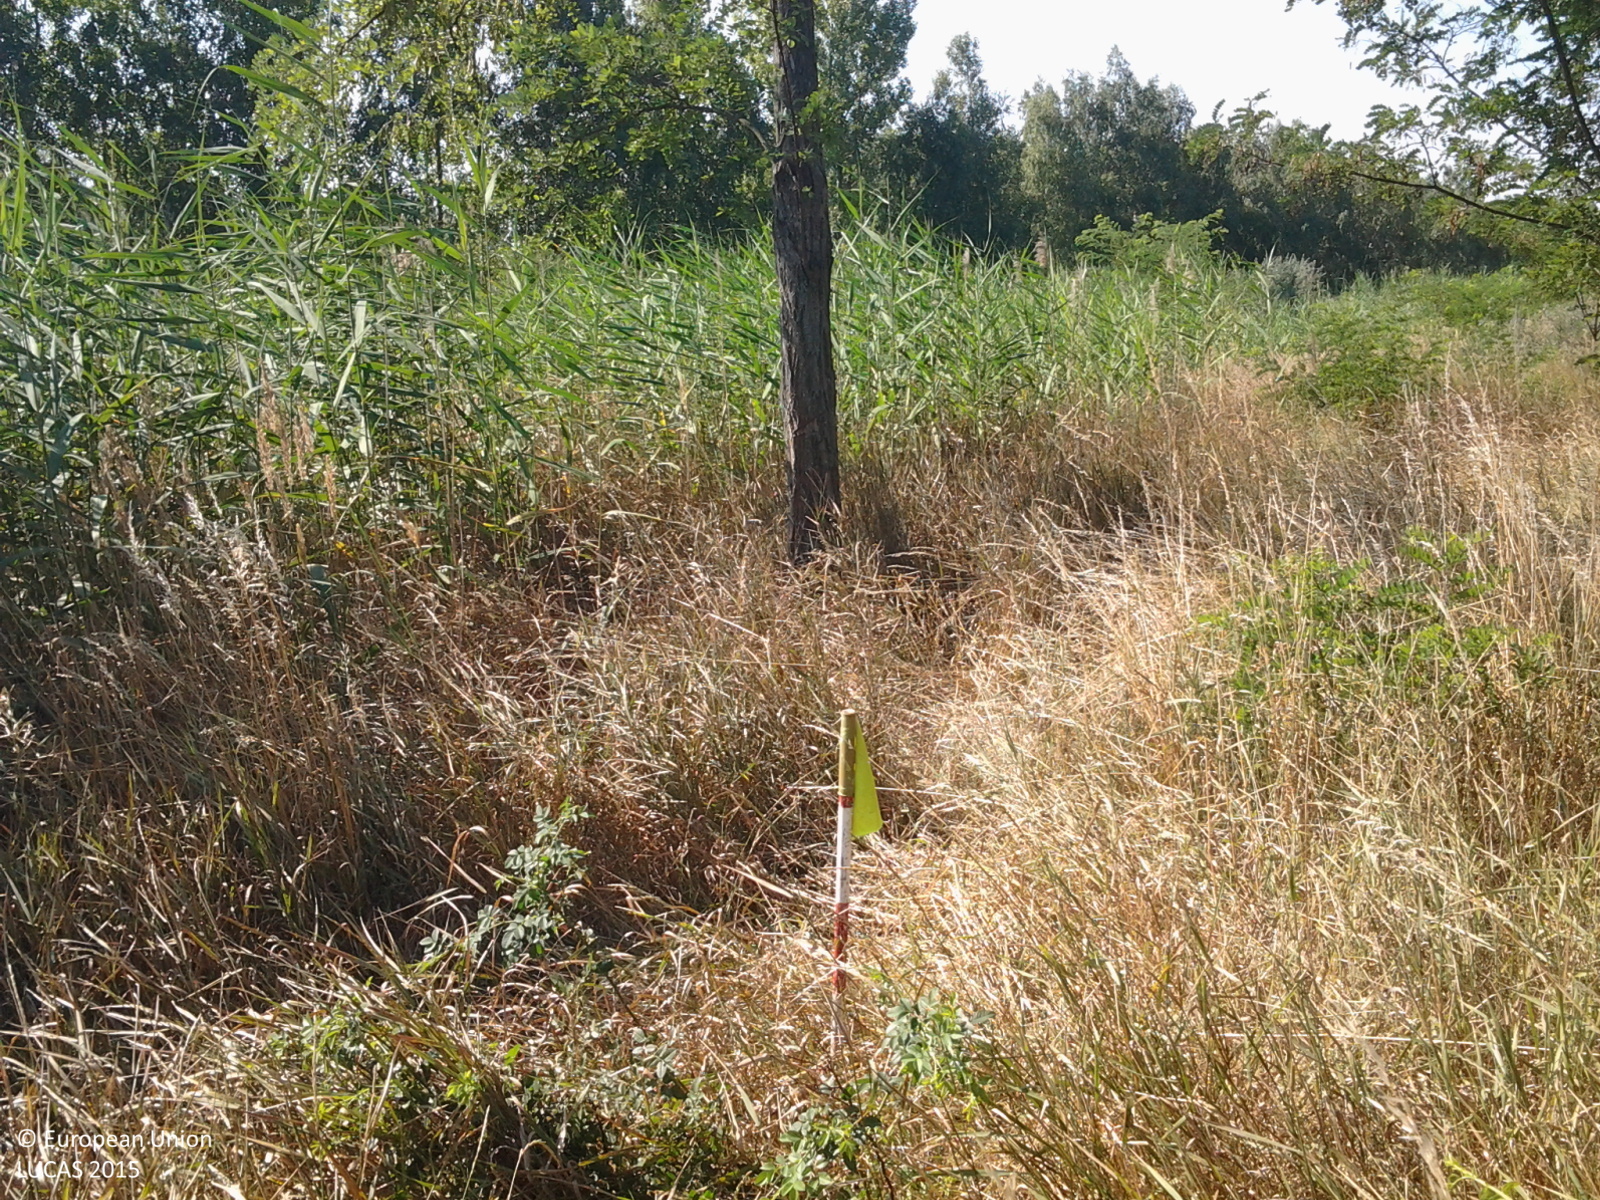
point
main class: Woodland
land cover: Broadleaved woodland
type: mire and swamp forests
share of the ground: 25 - 50 %
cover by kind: herbaceous plants 70 %, broadleaved forest trees 30 %
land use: Abandoned areas
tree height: < 5 m
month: July
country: HU
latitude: 47.3676
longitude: 20.5853
